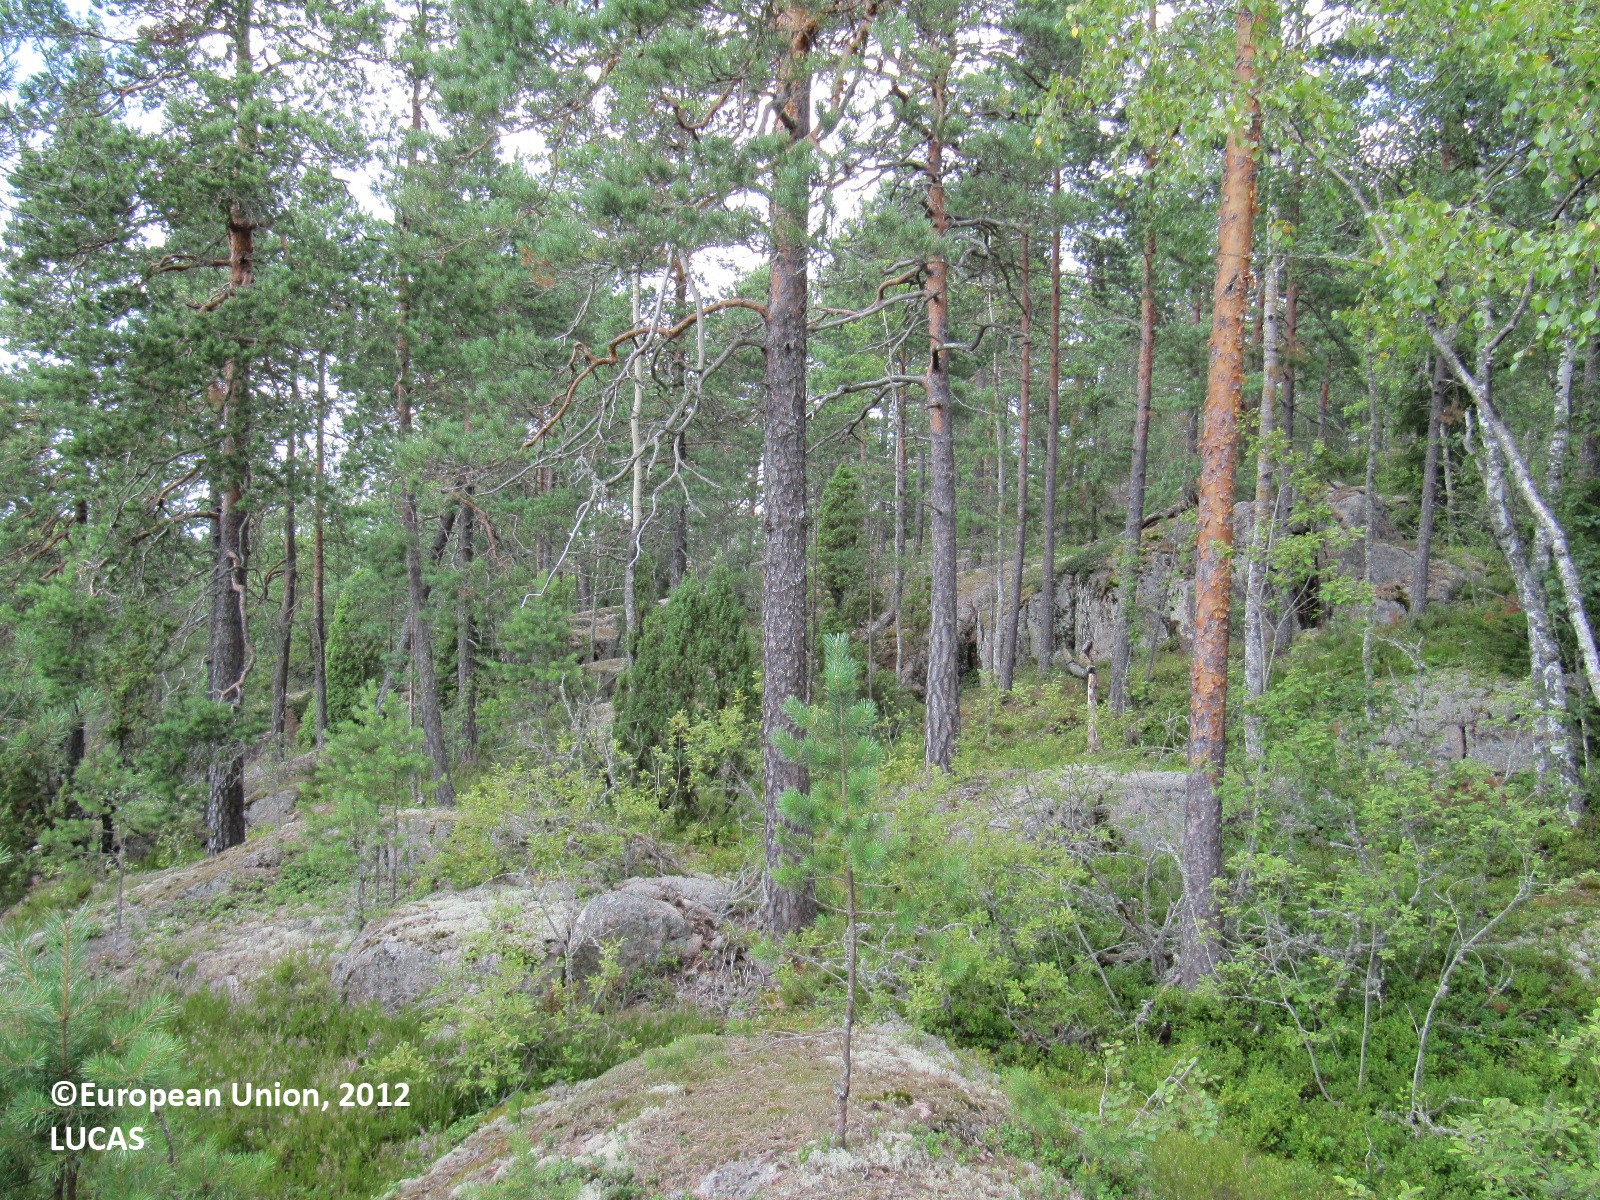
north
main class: Woodland
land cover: Pine dominated mixed woodland
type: boreal forest
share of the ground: 50 - 75 %
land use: Forestry
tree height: > 5 m
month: August
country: FI
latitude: 60.3802
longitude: 23.1964
